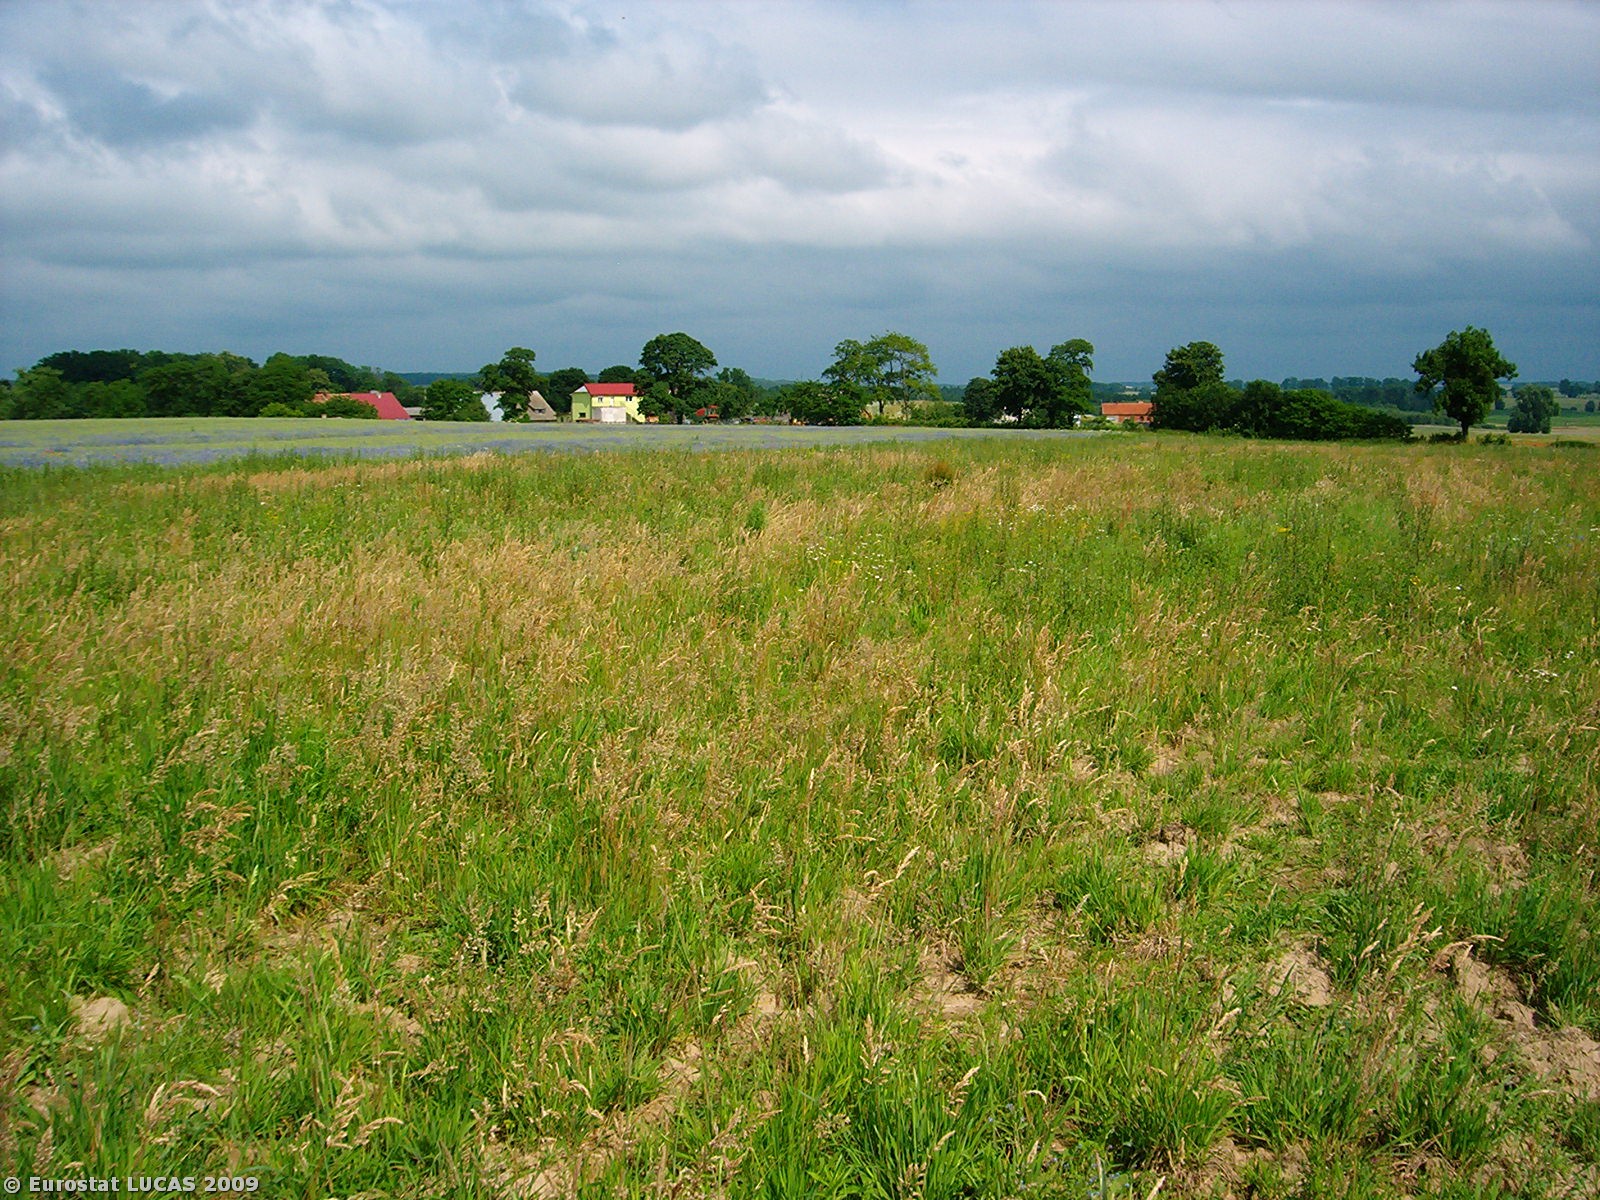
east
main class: Grassland
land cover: Spontaneously vegetated surfaces
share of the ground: > 75 %
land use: Unused
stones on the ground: < 10 %
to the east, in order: Spontaneously vegetated surfaces; Common wheat
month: June
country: PL
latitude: 53.1885
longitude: 15.4660
